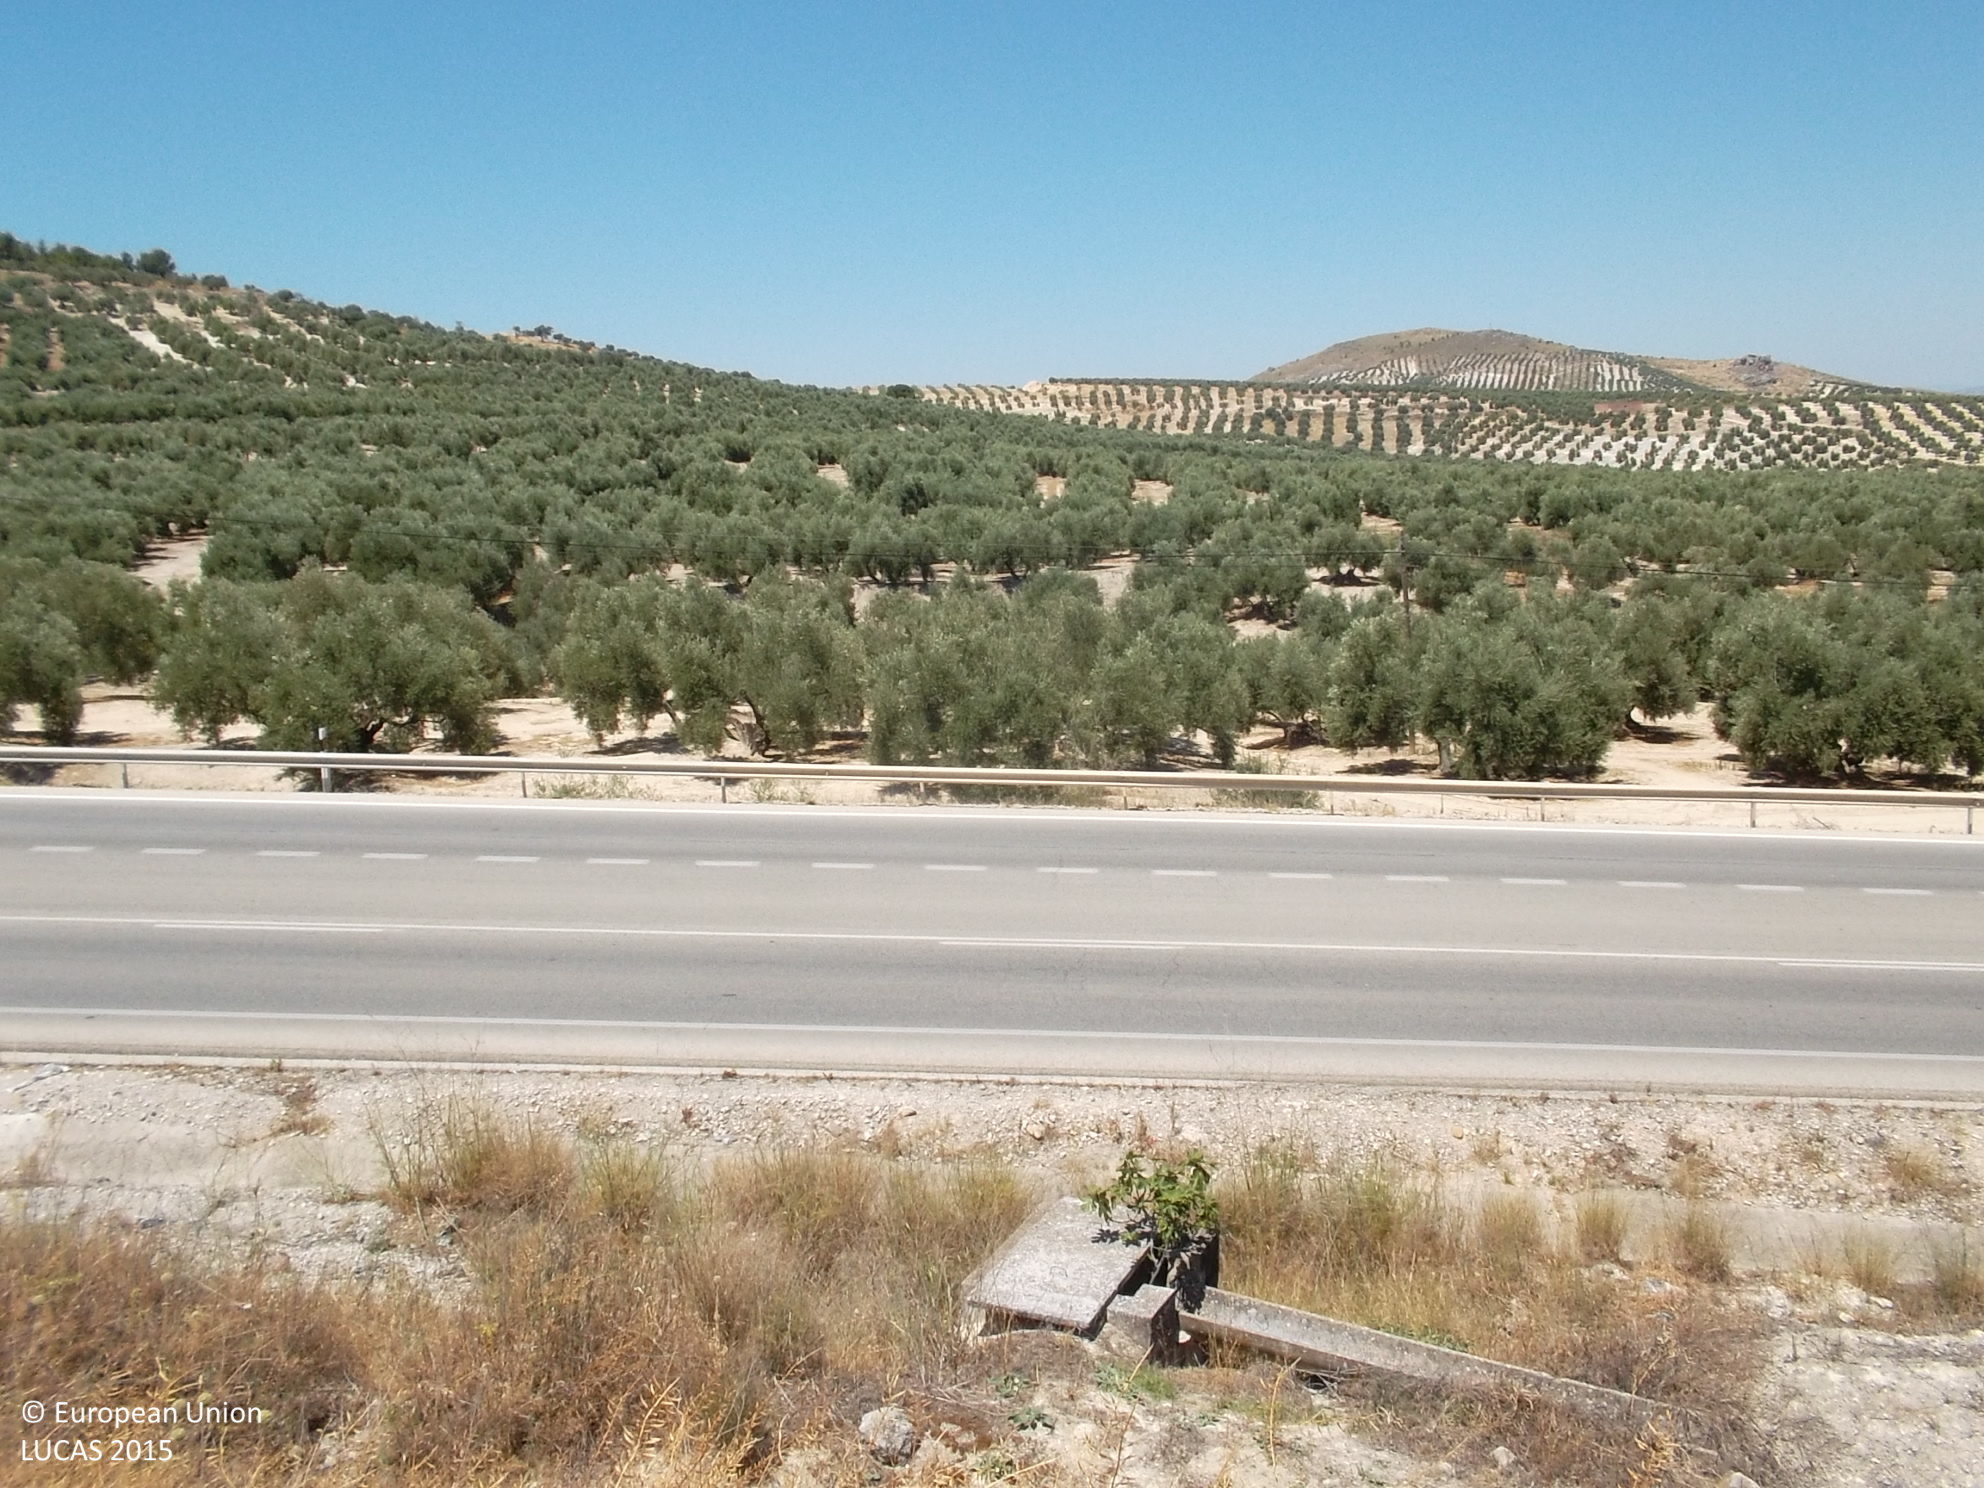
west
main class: Grassland
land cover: Grassland without tree/shrub cover
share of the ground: 25 - 50 %
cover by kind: herbaceous plants 55 %, unconsolidated bare surface 40 %, shrubs 5 %
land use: Semi-natural and natural areas not in use
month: June
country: ES
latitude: 37.8654
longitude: -3.3541
